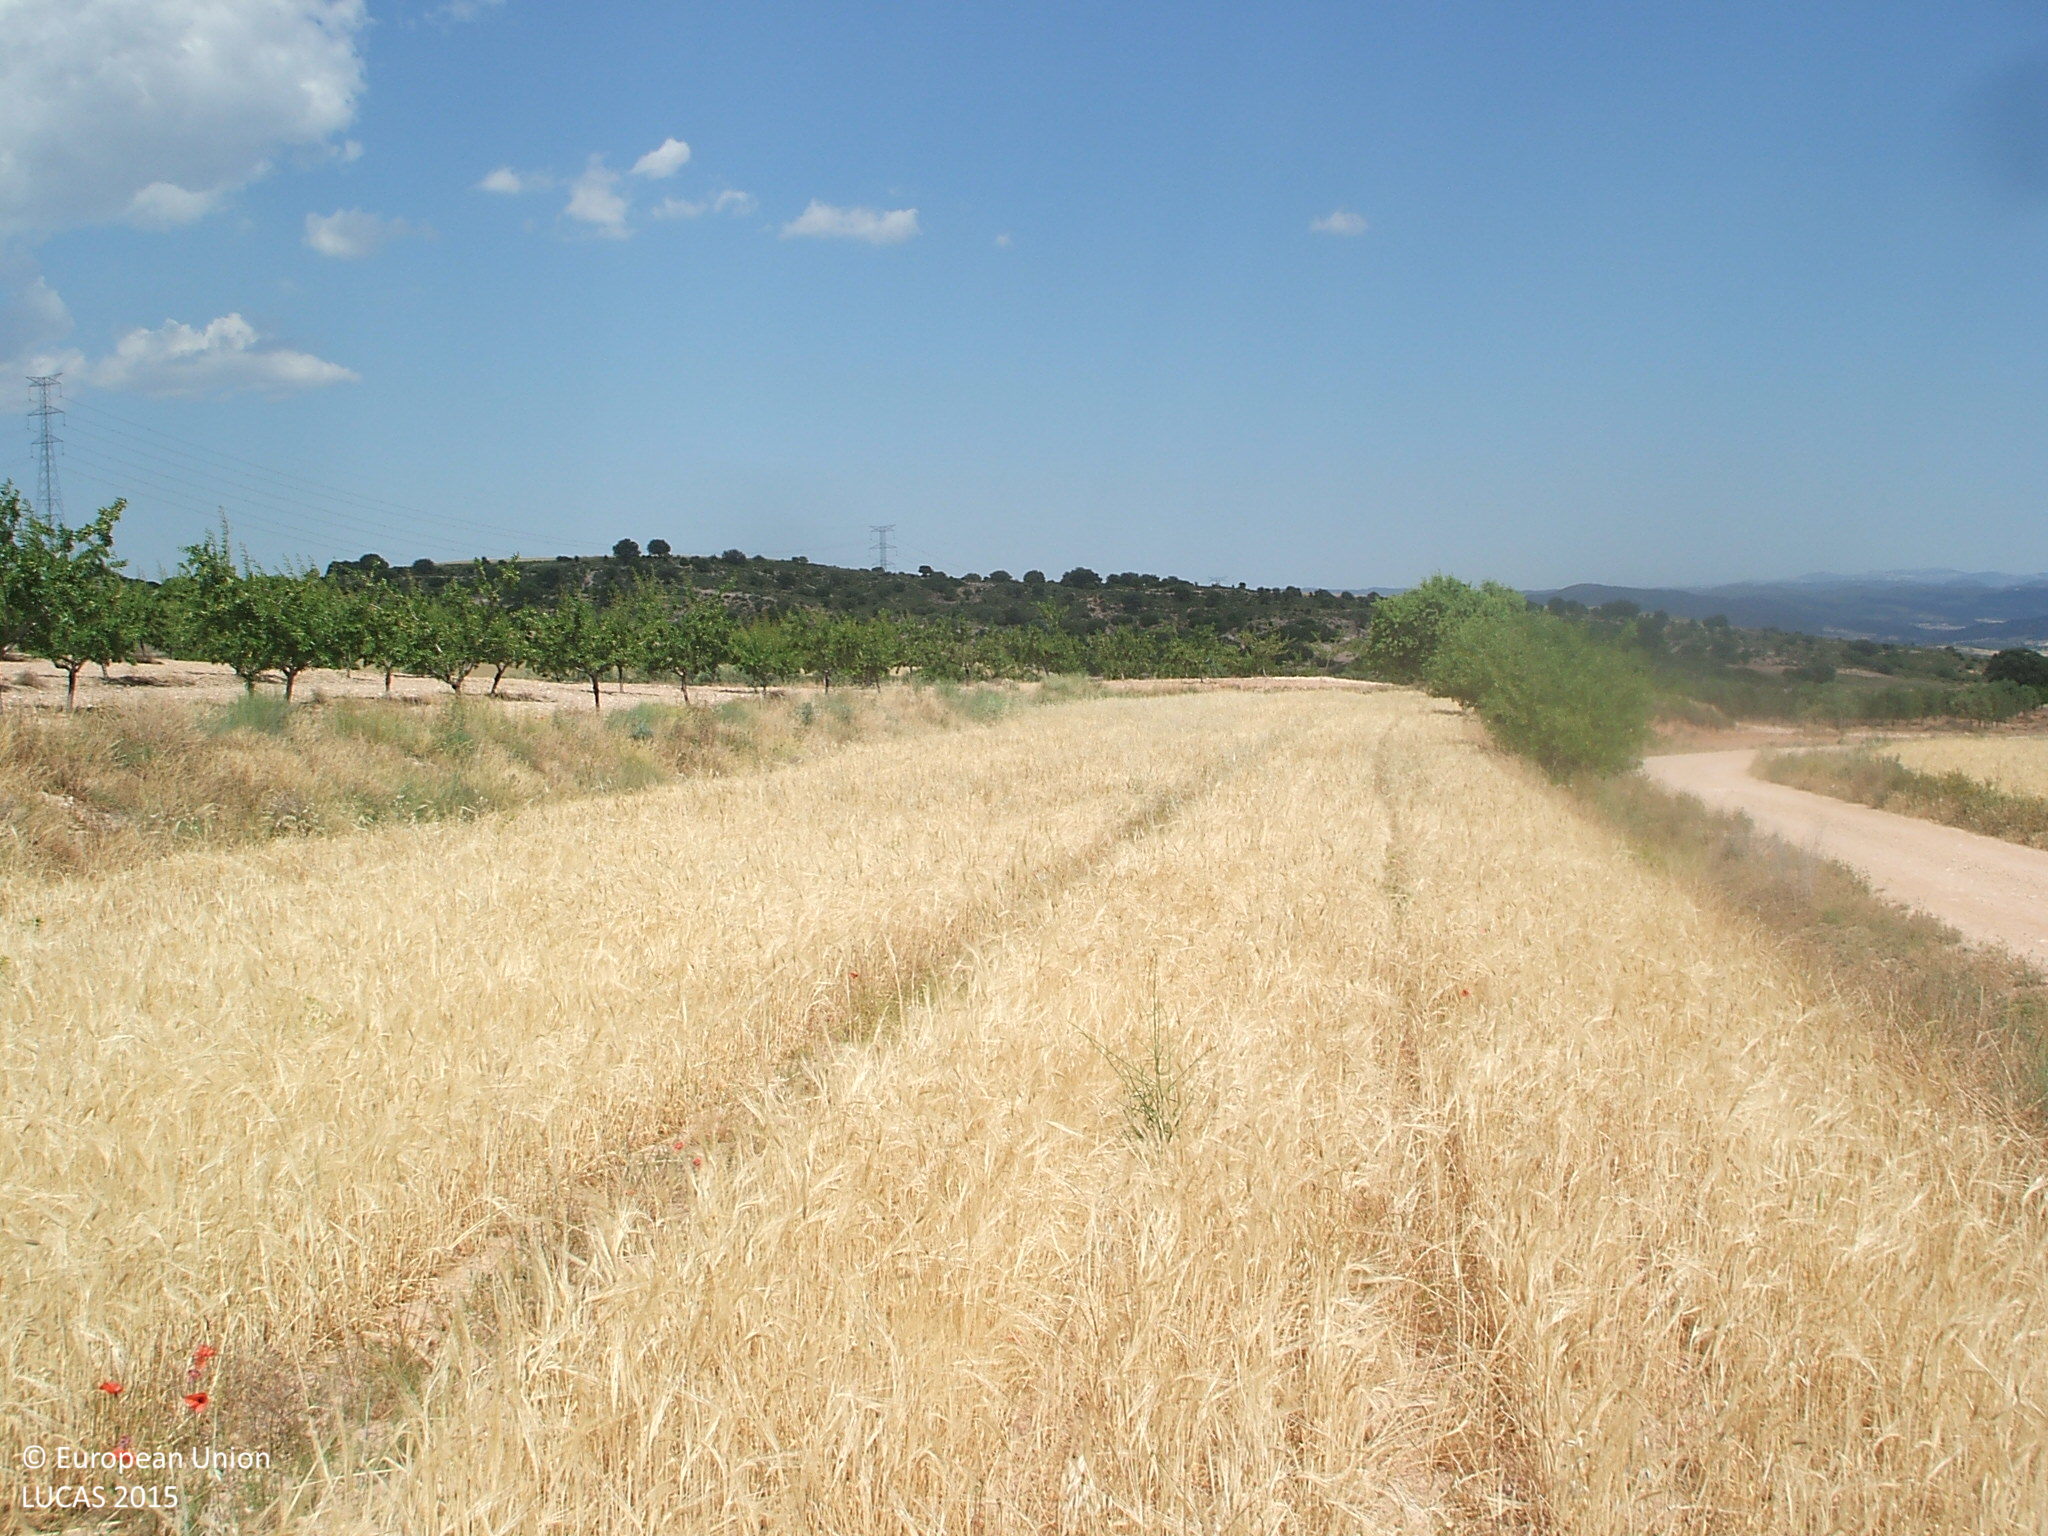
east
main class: Cropland
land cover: Barley
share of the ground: > 75 %
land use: Agriculture (excluding fallow land and kitchen gardens)
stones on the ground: > 50 %
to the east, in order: Barley; Grass margins; Nuts trees; Olive groves; Nuts trees; Grass margins; Nuts trees; Grass margins; Nuts trees
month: June
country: ES
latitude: 40.8743
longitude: -0.2747
